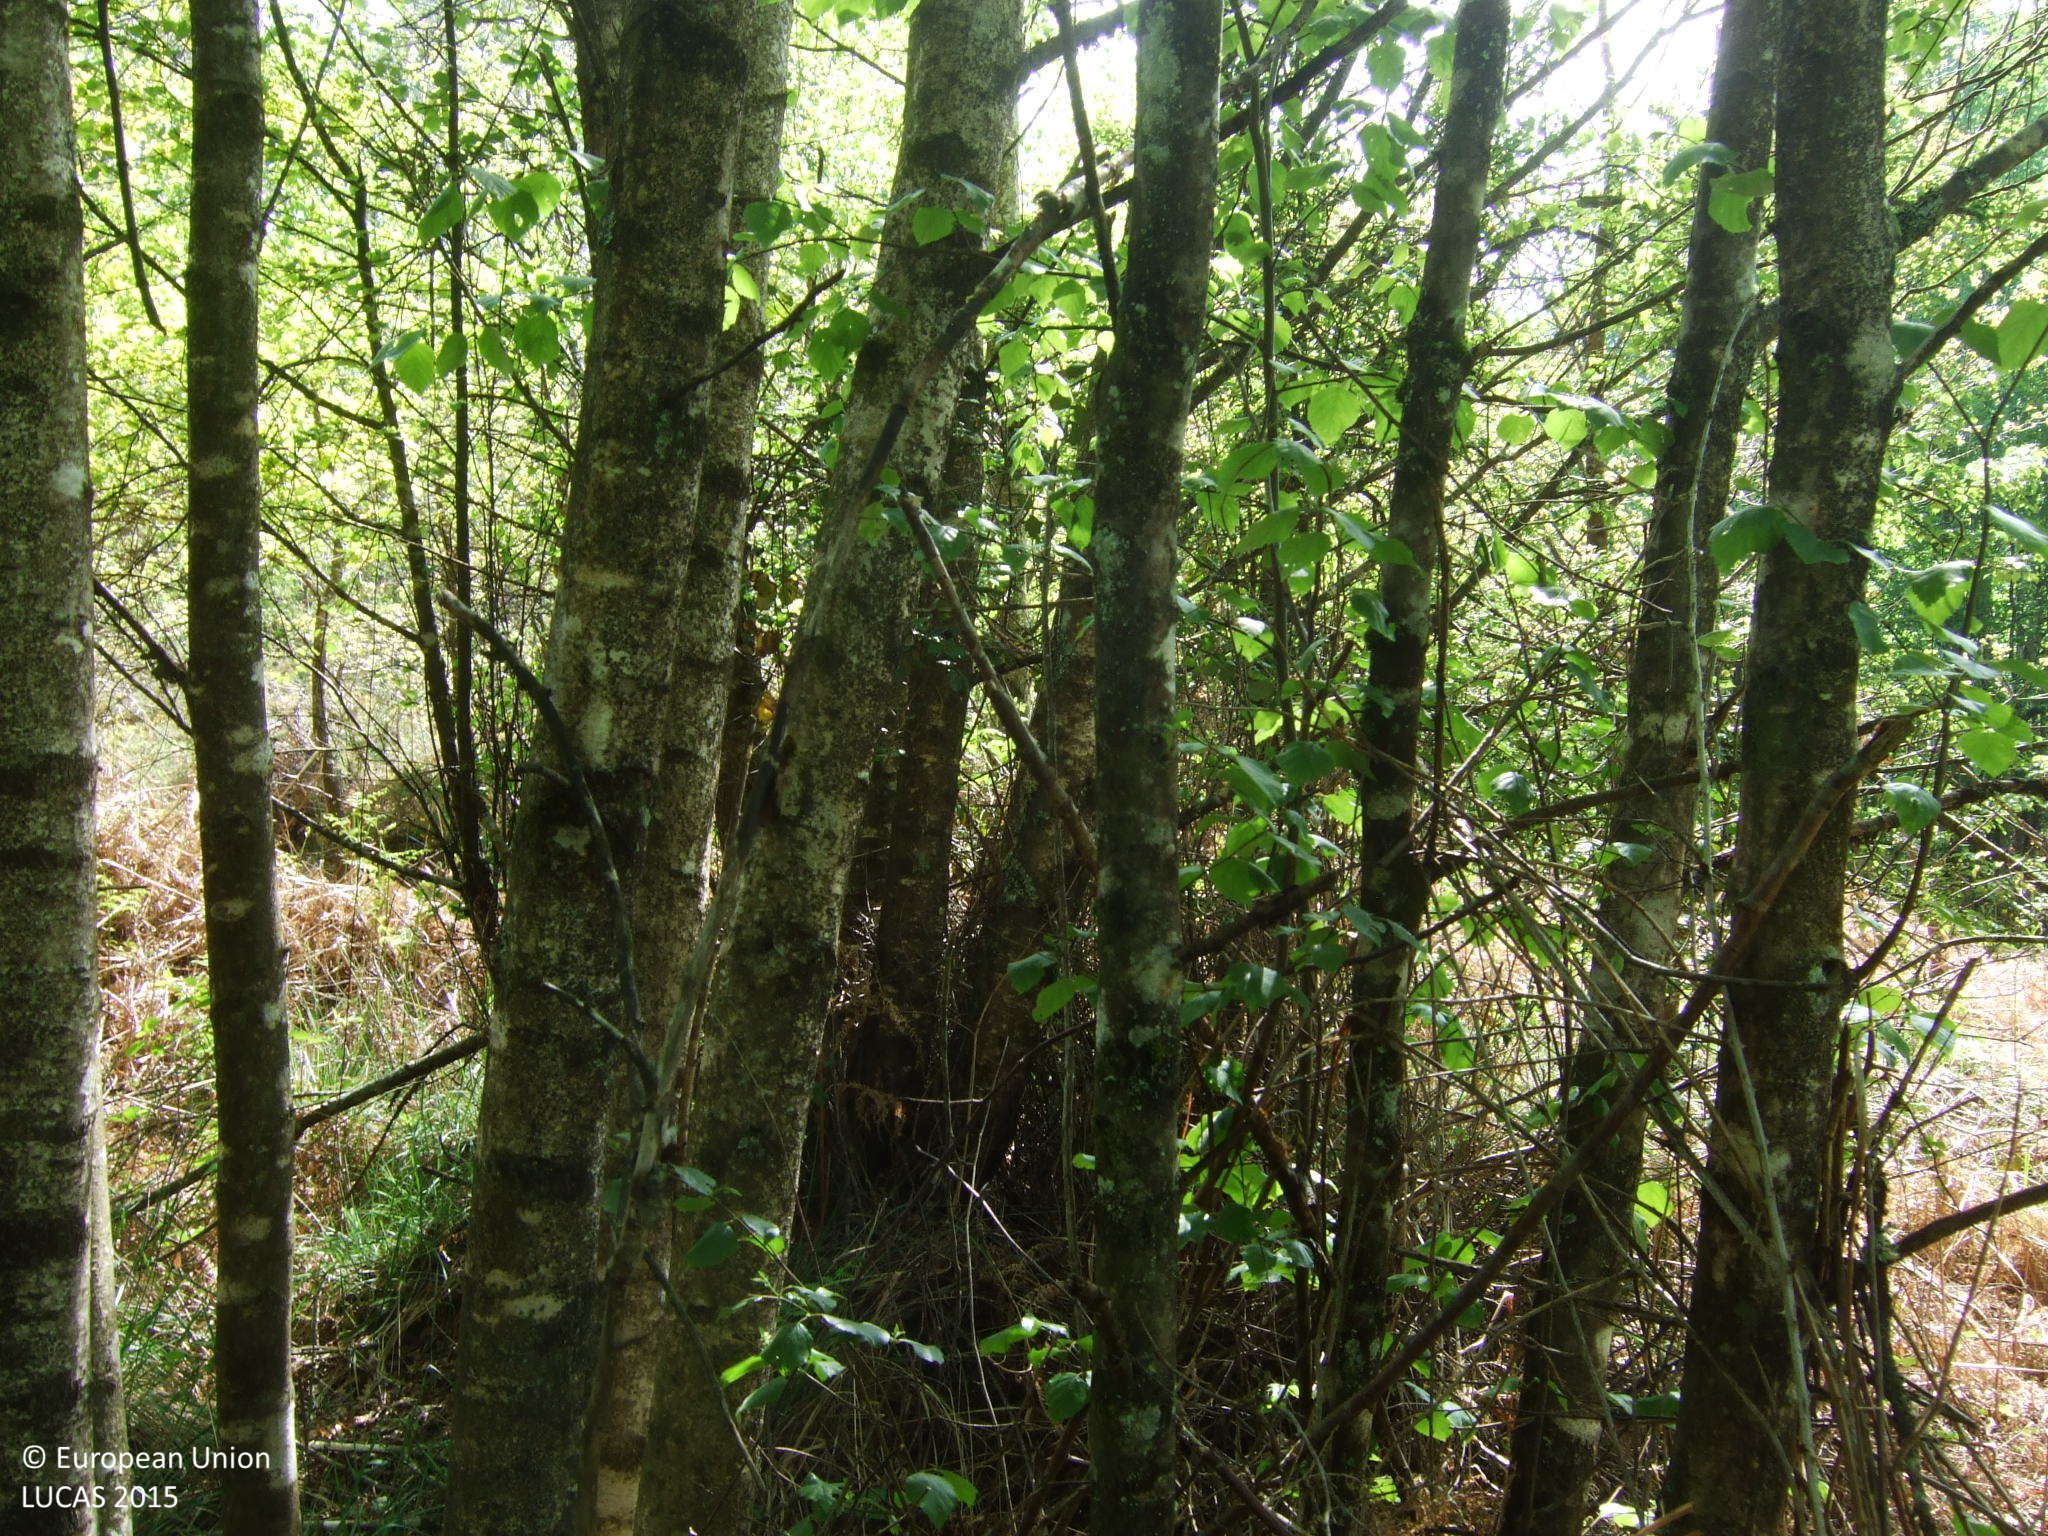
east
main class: Grassland
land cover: Grassland with sparse tree/shrub cover
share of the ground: > 75 %
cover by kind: herbaceous plants 95 %, broadleaved forest trees 5 %
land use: Agriculture (excluding fallow land and kitchen gardens)
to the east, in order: Grassland with sparse tree/shrub cover; Abandoned hedges; Shrubland with sparse tree cover; Broadleaved woodland; Pine dominated coniferous woodland; Shrubland with sparse tree cover; Grassland without tree/shrub cover; Broadleaved woodland
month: May
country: ES
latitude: 42.9948
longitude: -7.4043
